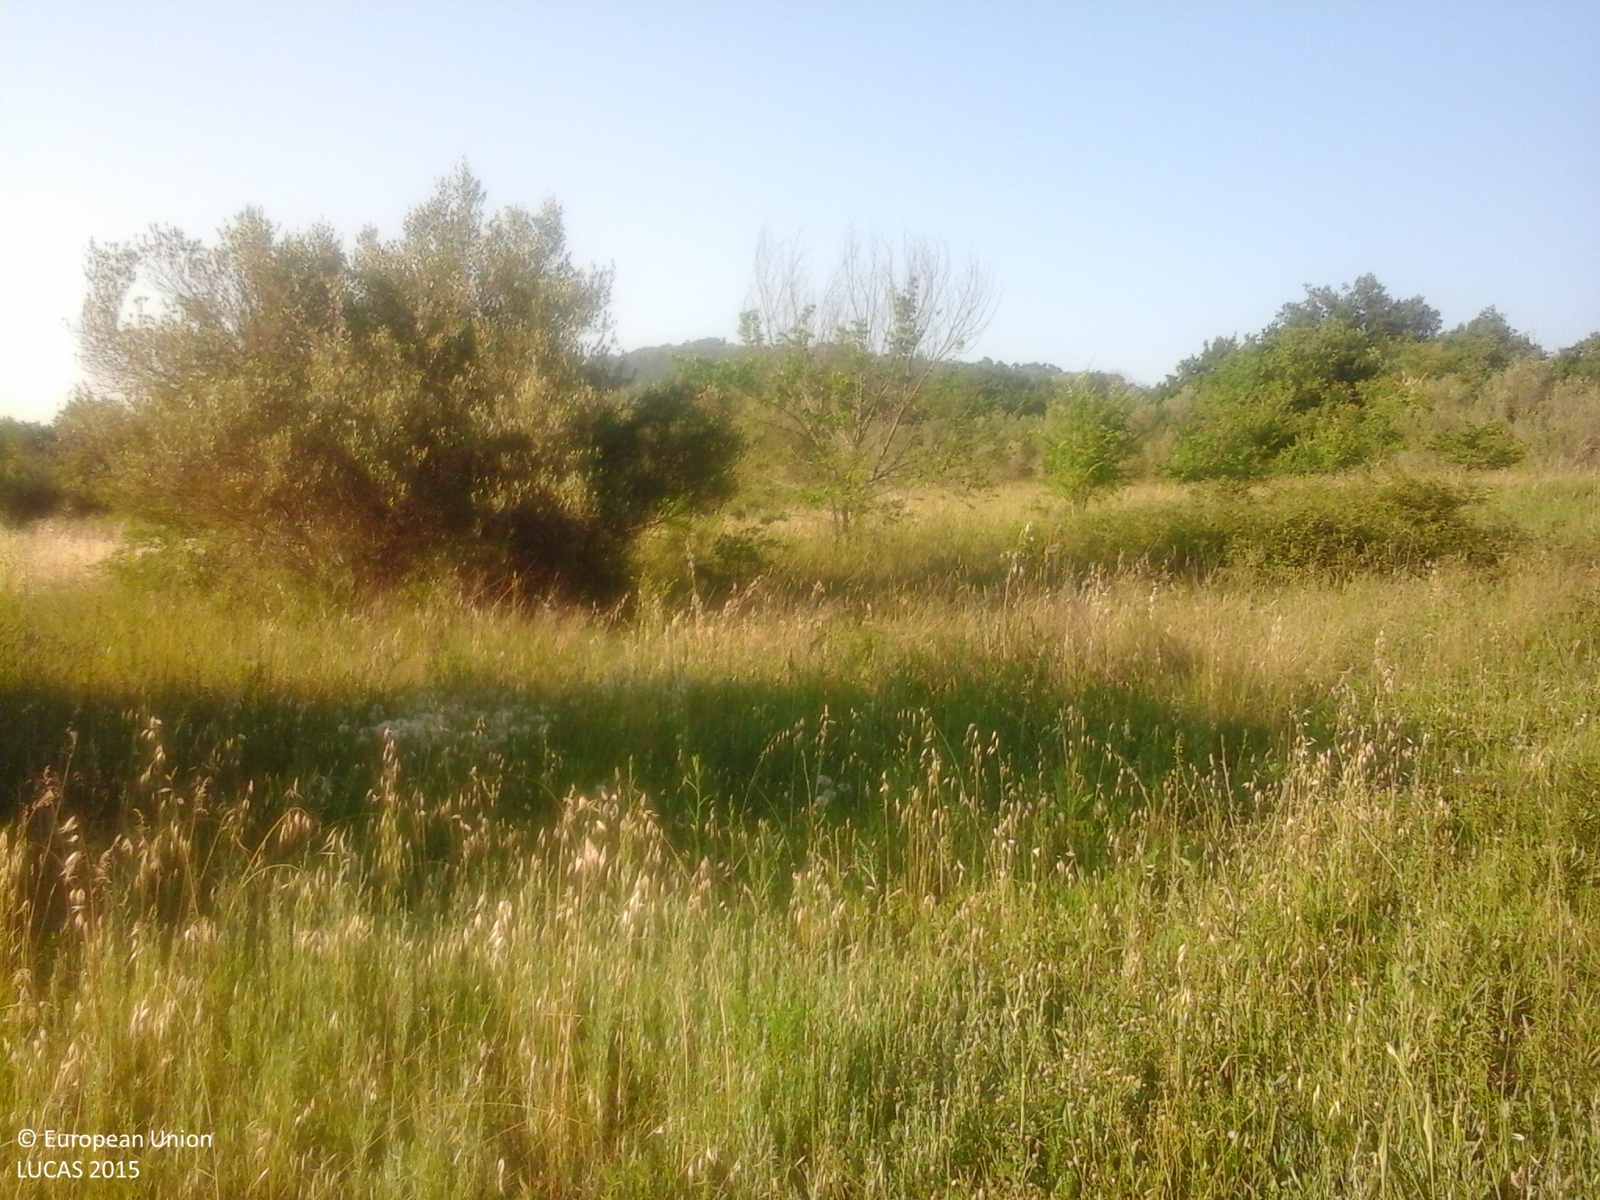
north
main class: Grassland
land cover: Grassland without tree/shrub cover
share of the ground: 25 - 50 %
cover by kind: herbaceous plants 95 %, shrubs 5 %
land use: Abandoned areas
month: June
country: IT
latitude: 42.0362
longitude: 14.3468
